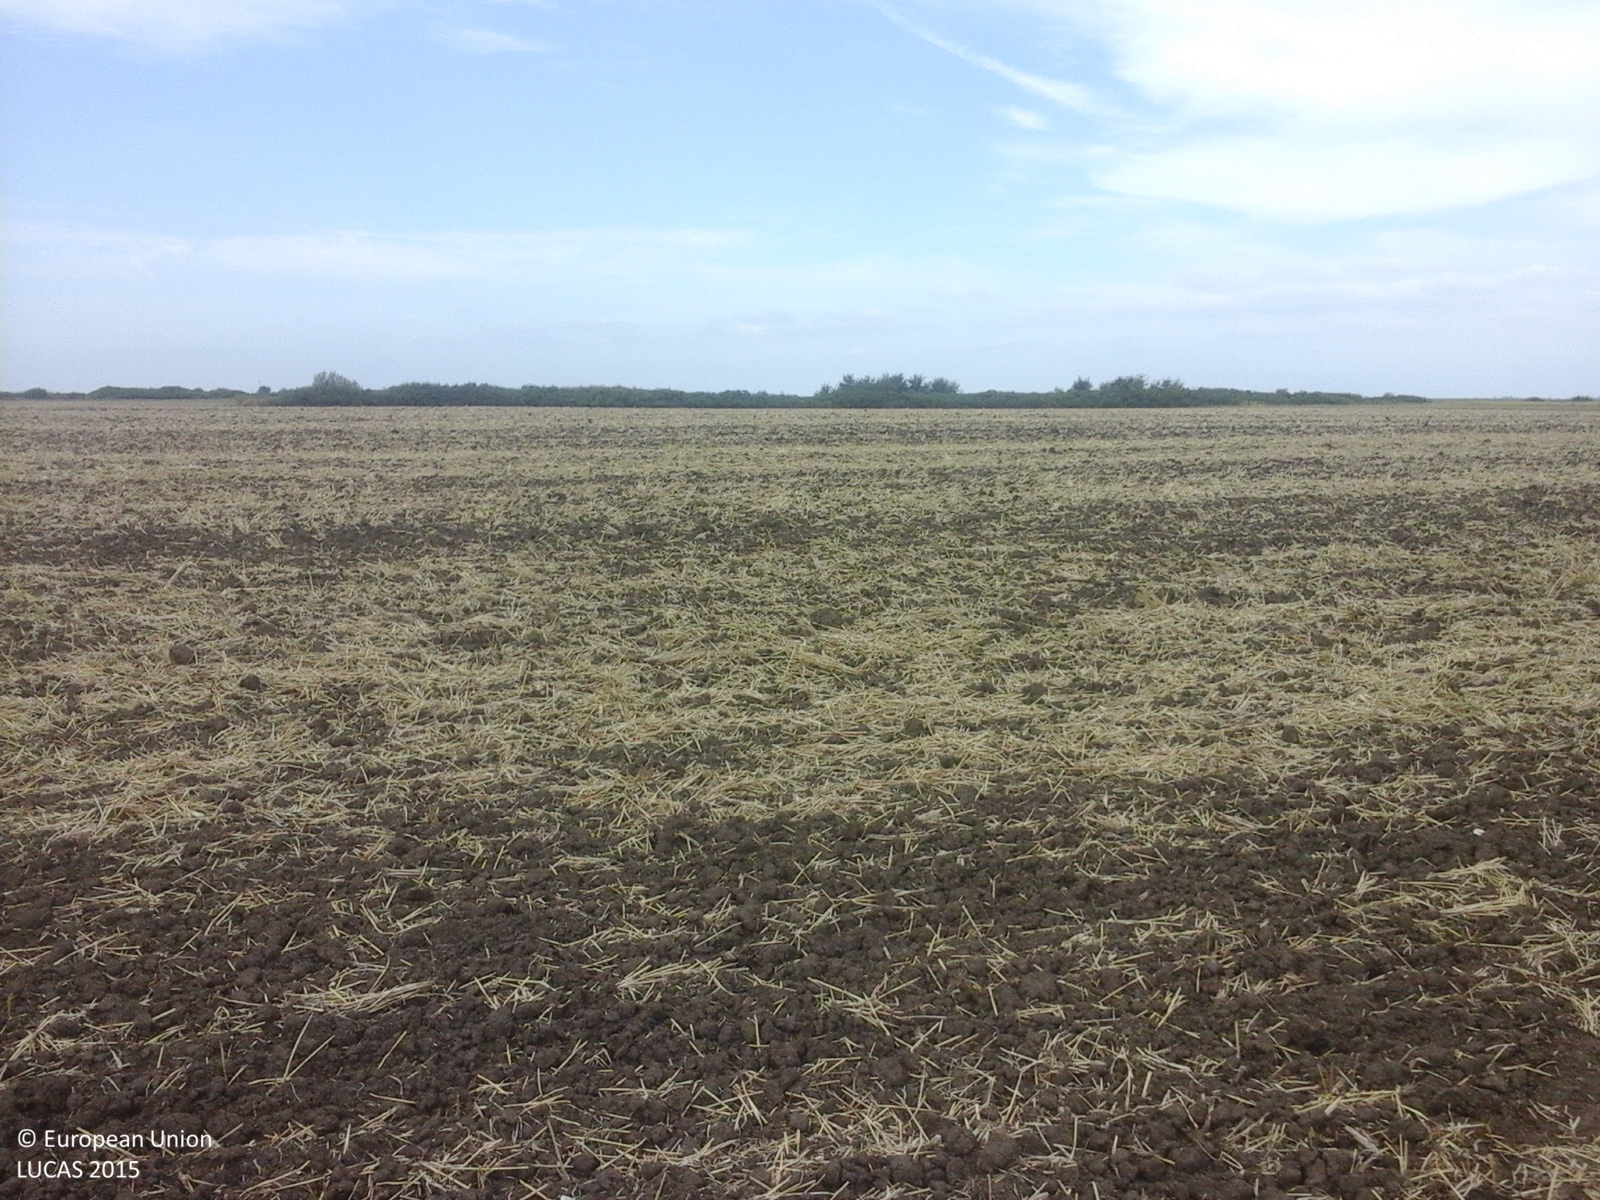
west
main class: Cropland
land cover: Common wheat
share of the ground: < 10 %
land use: Agriculture (excluding fallow land and kitchen gardens)
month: August
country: RO
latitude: 45.2970
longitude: 21.2885
